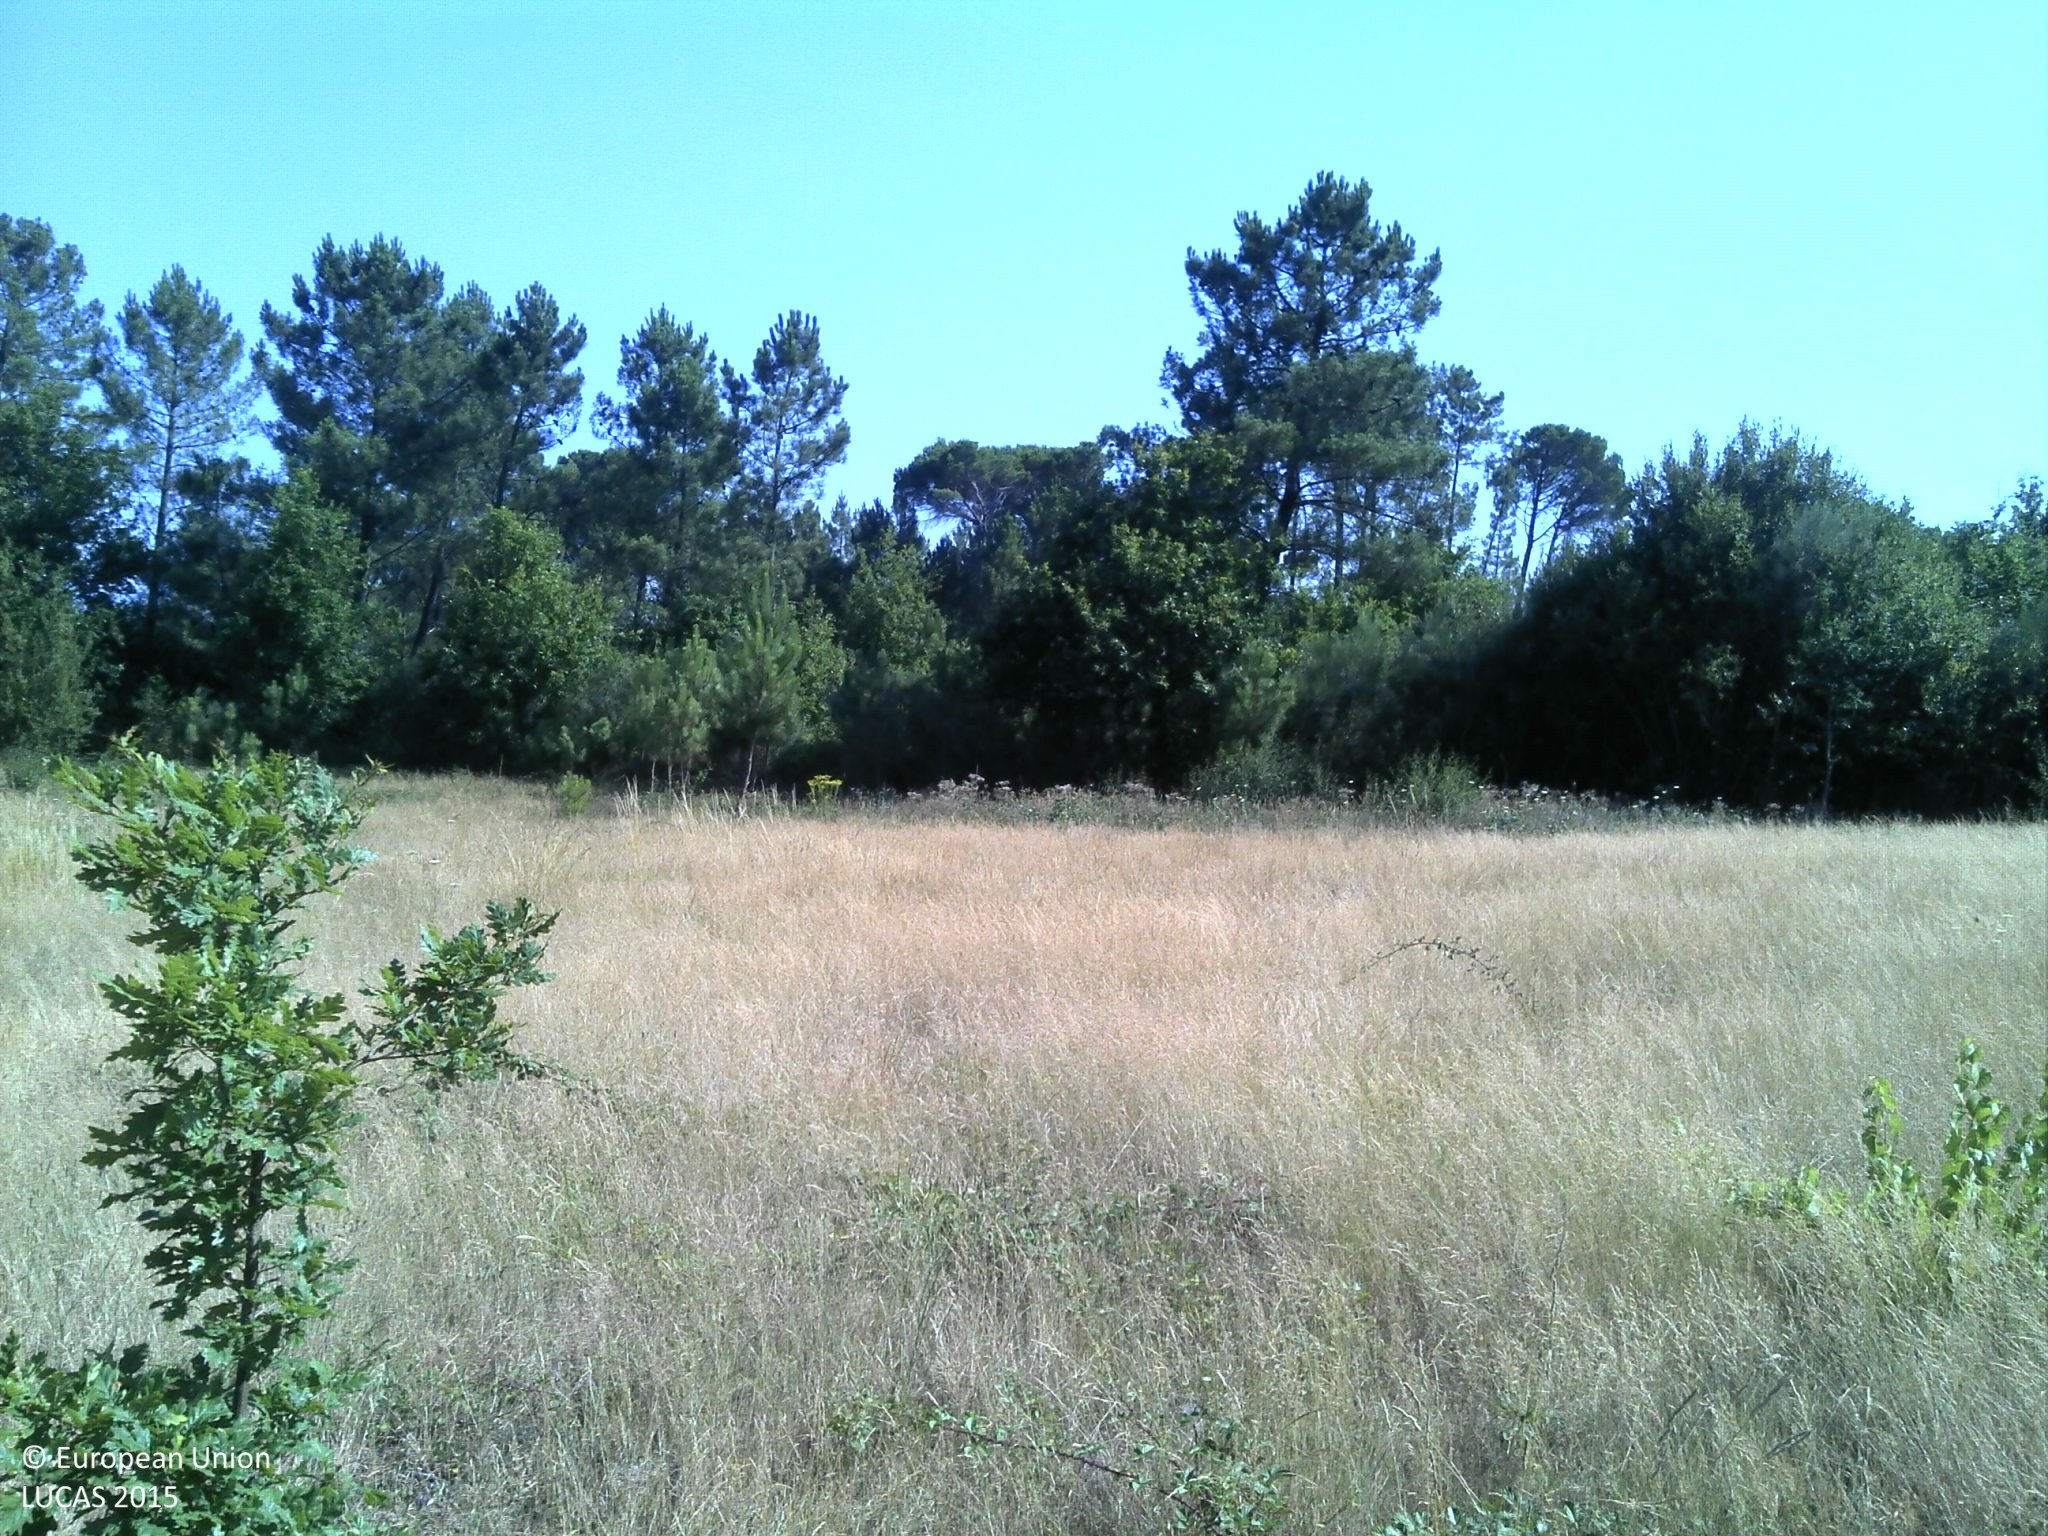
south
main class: Grassland
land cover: Grassland without tree/shrub cover
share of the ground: > 75 %
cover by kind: herbaceous plants 80 %, unconsolidated bare surface 20 %
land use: Agriculture (excluding fallow land and kitchen gardens)
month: July
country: PT
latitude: 40.4465
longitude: -7.9367
